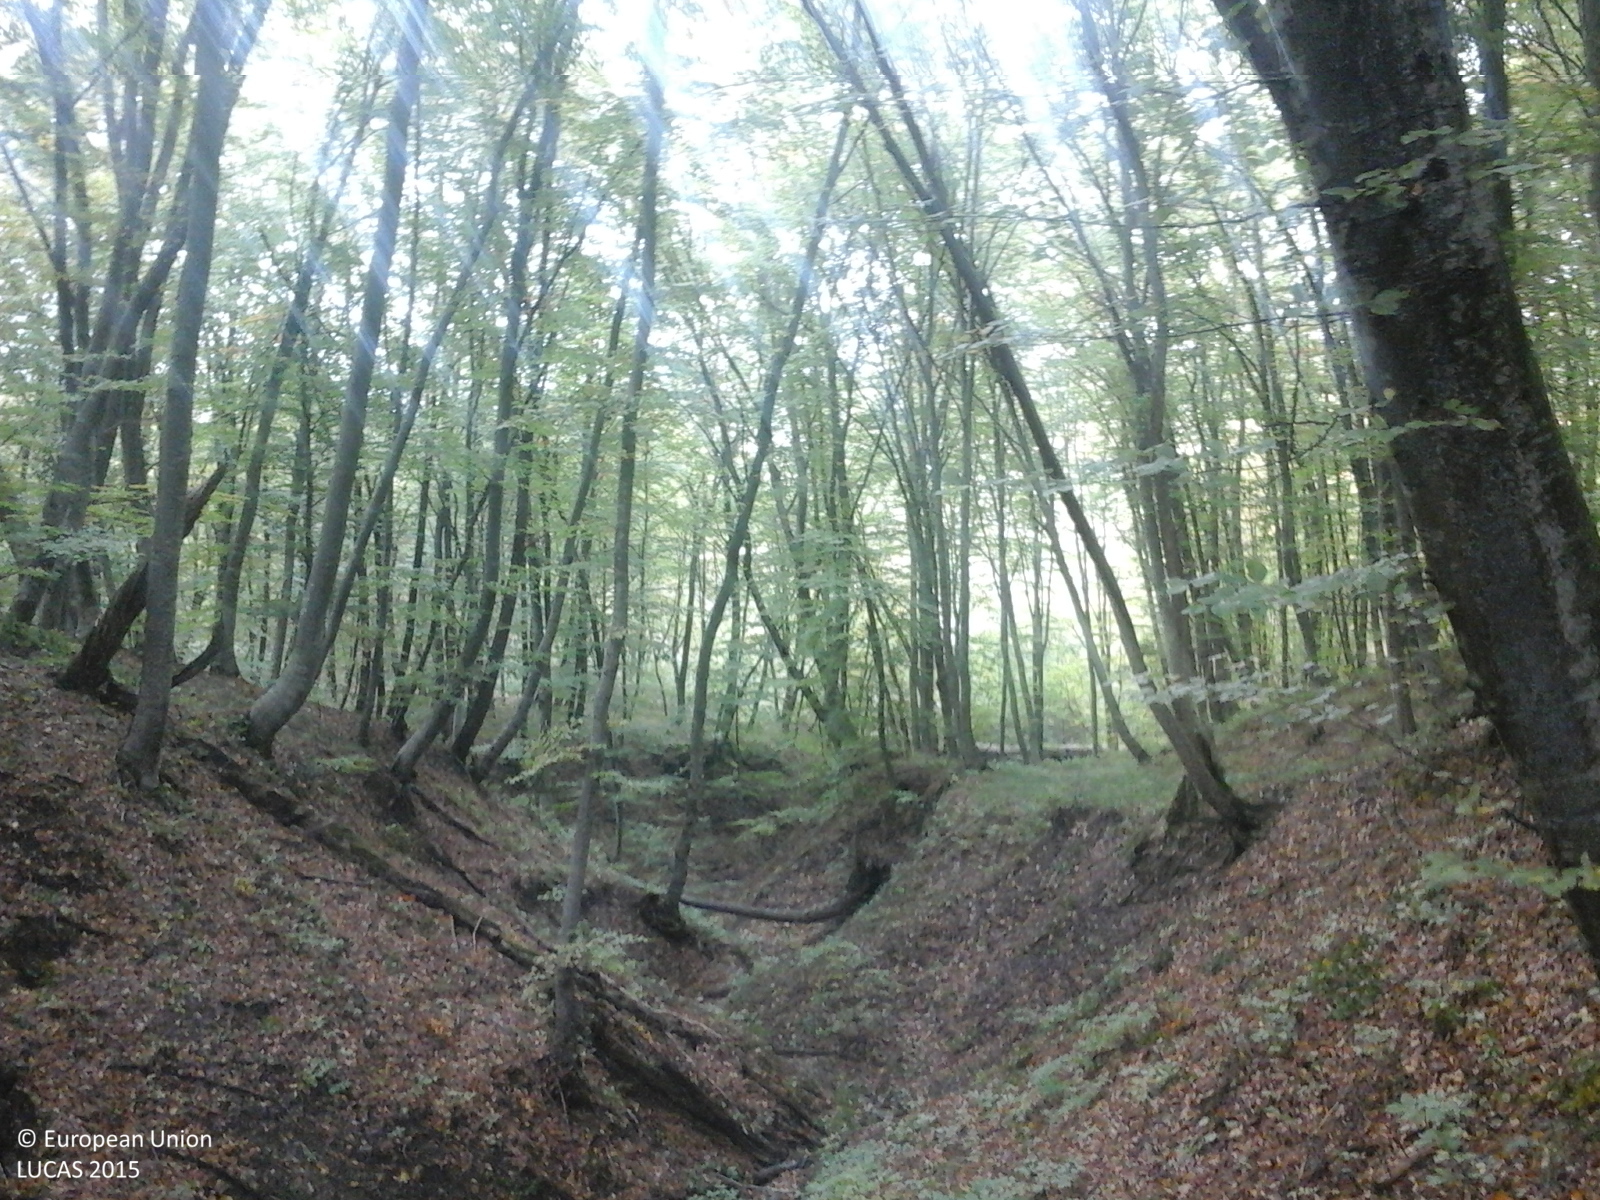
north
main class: Woodland
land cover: Broadleaved woodland
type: beech forest
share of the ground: > 75 %
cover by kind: broadleaved forest trees 100 %
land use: Forestry
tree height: > 5 m
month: October
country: RO
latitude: 46.2664
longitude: 25.0570
